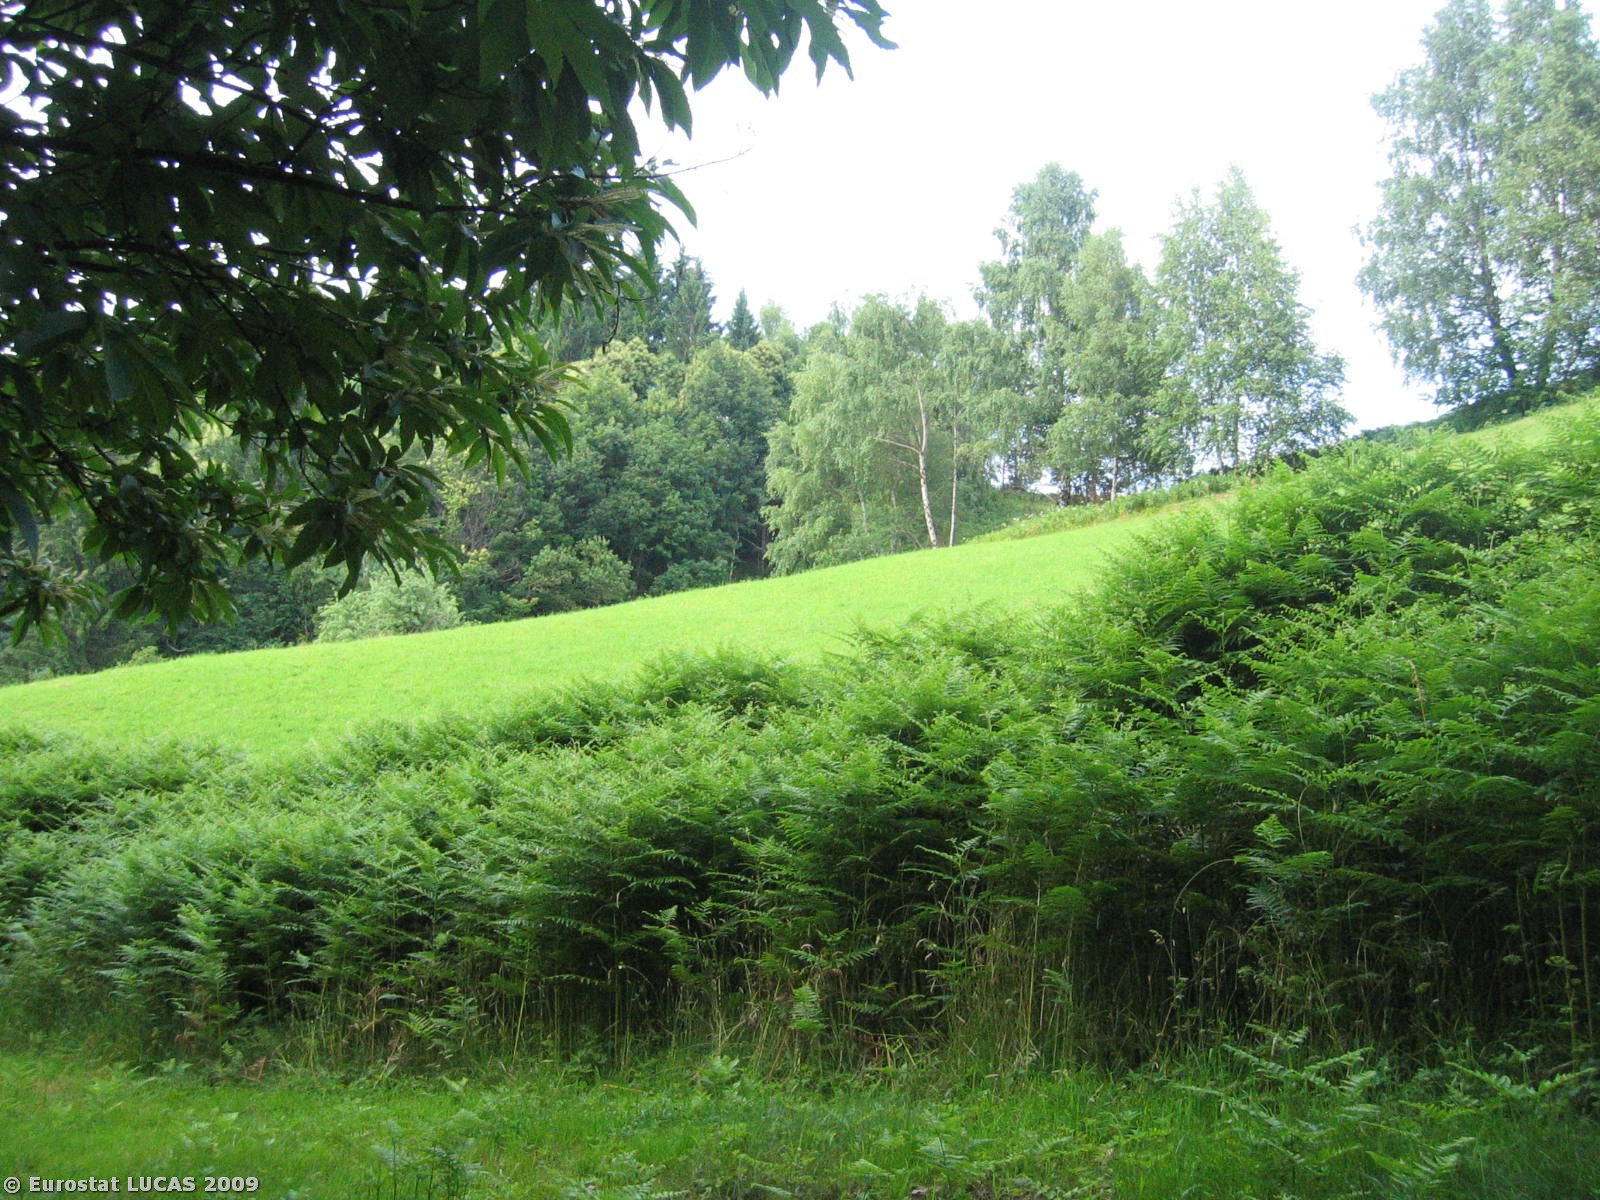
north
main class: Woodland
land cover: Broadleaved woodland
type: mountainous beech forest
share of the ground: > 75 %
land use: Forestry
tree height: > 5 m
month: July
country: SI
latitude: 46.0694
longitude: 14.2241
